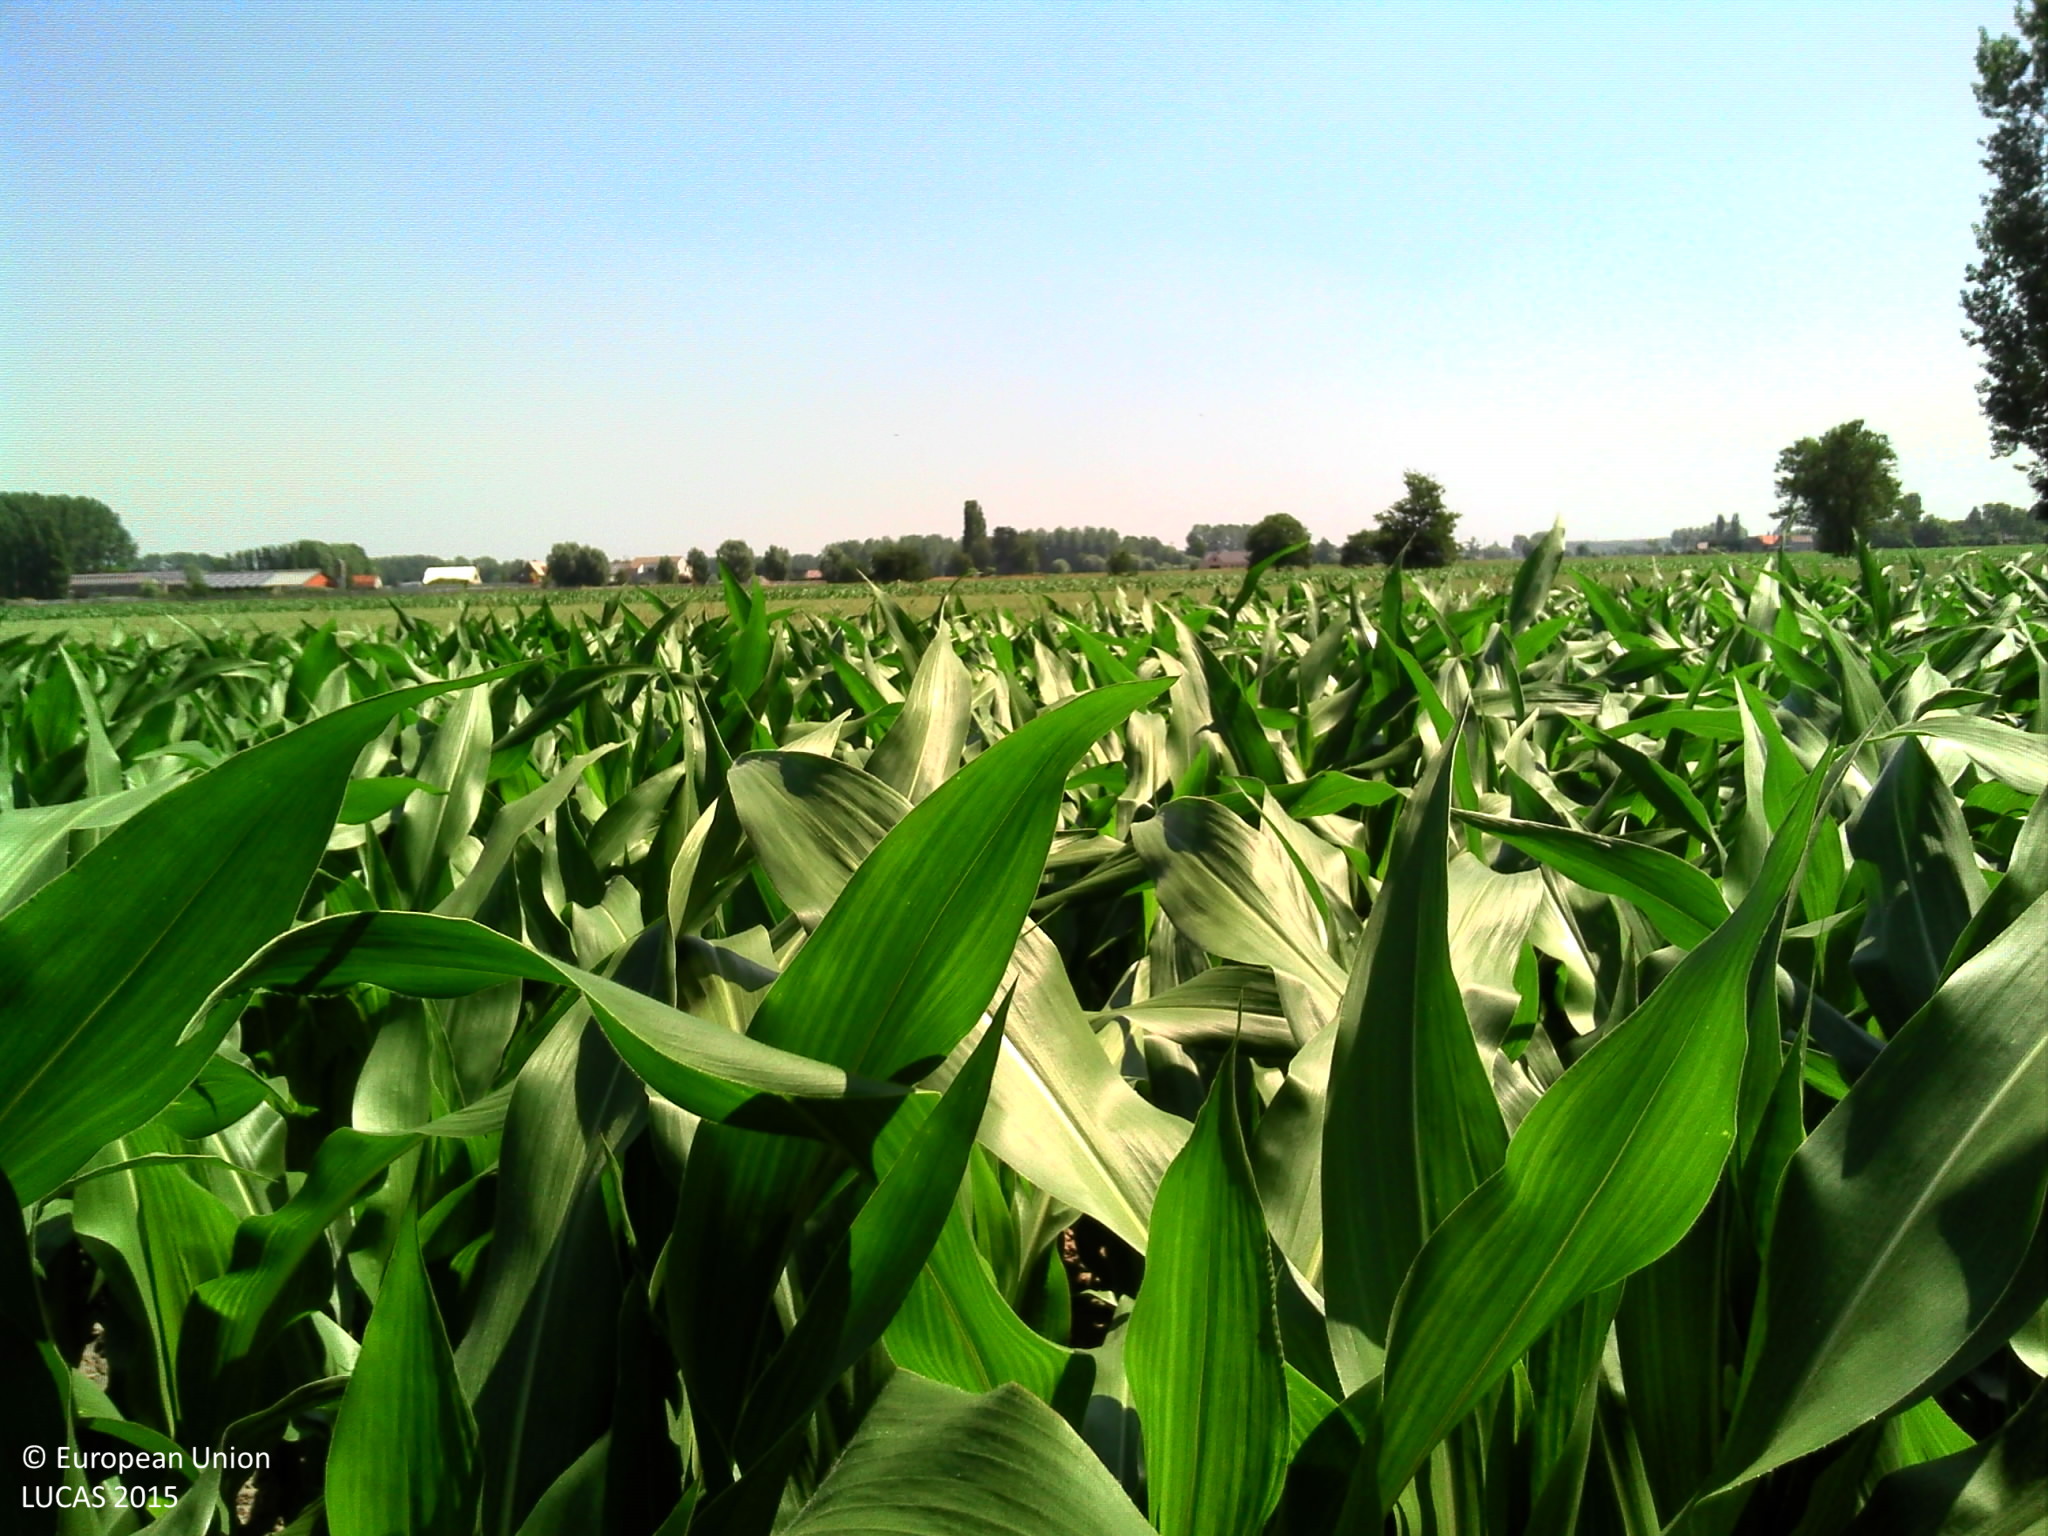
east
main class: Cropland
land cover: Maize
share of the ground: > 75 %
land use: Agriculture (excluding fallow land and kitchen gardens)
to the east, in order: Maize; Grass margins; Ditches and canals; Grass margins; Common wheat; Grass margins; Ditches and canals; Grass margins; Maize; Grass margins; Ditches and canals; Grass margins; Maize
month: June
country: BE
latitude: 51.1620
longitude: 3.6581
